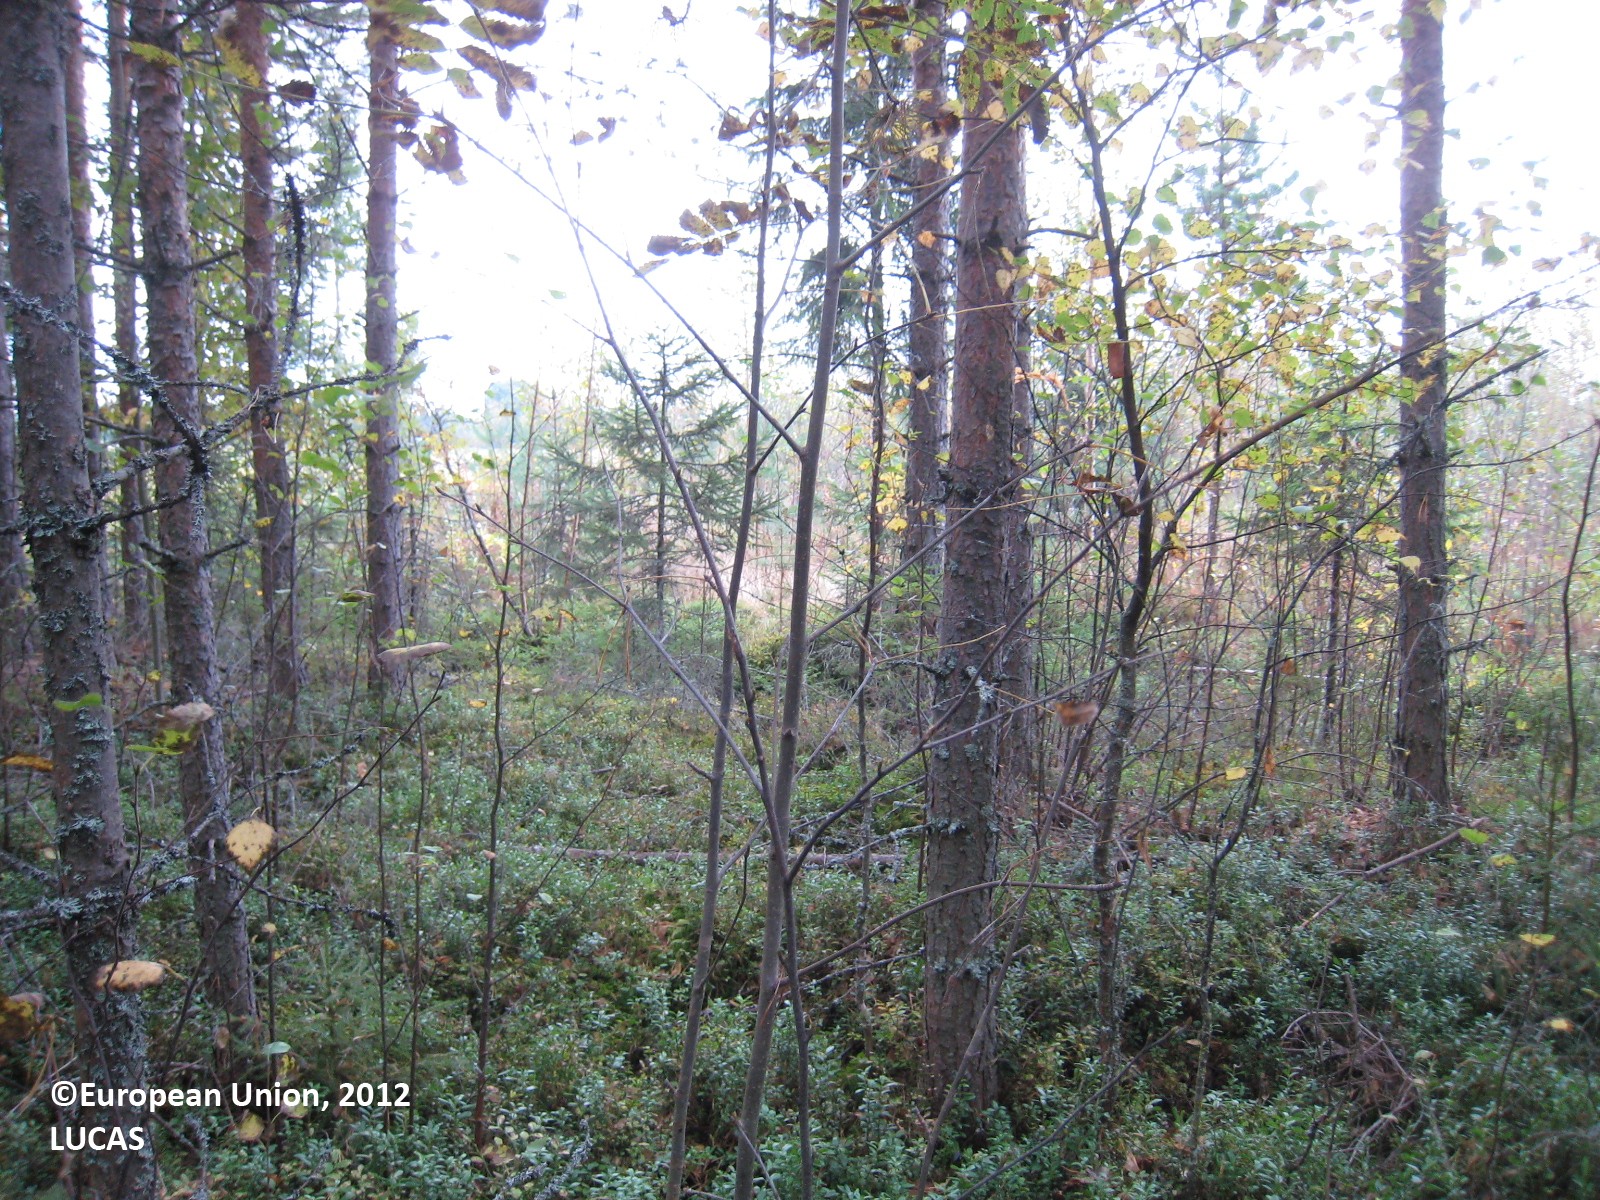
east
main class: Woodland
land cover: Pine dominated coniferous woodland
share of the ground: > 75 %
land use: Forestry
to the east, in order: Pine dominated coniferous woodland; Ditches and canals; Pine dominated mixed woodland; Ditches and canals; Pine dominated mixed woodland; Ditches and canals; Pine dominated mixed woodland; Ditches and canals; Broadleaved woodland; Ditches and canals; Shruby margins; Oats; Grassland with sparse tree/shrub cover; Oats; Shruby margins; Abandoned hedges; Ditches and canals; Shruby margins; Rape and turnip rape
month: September
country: FI
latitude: 62.6932
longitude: 26.6501
